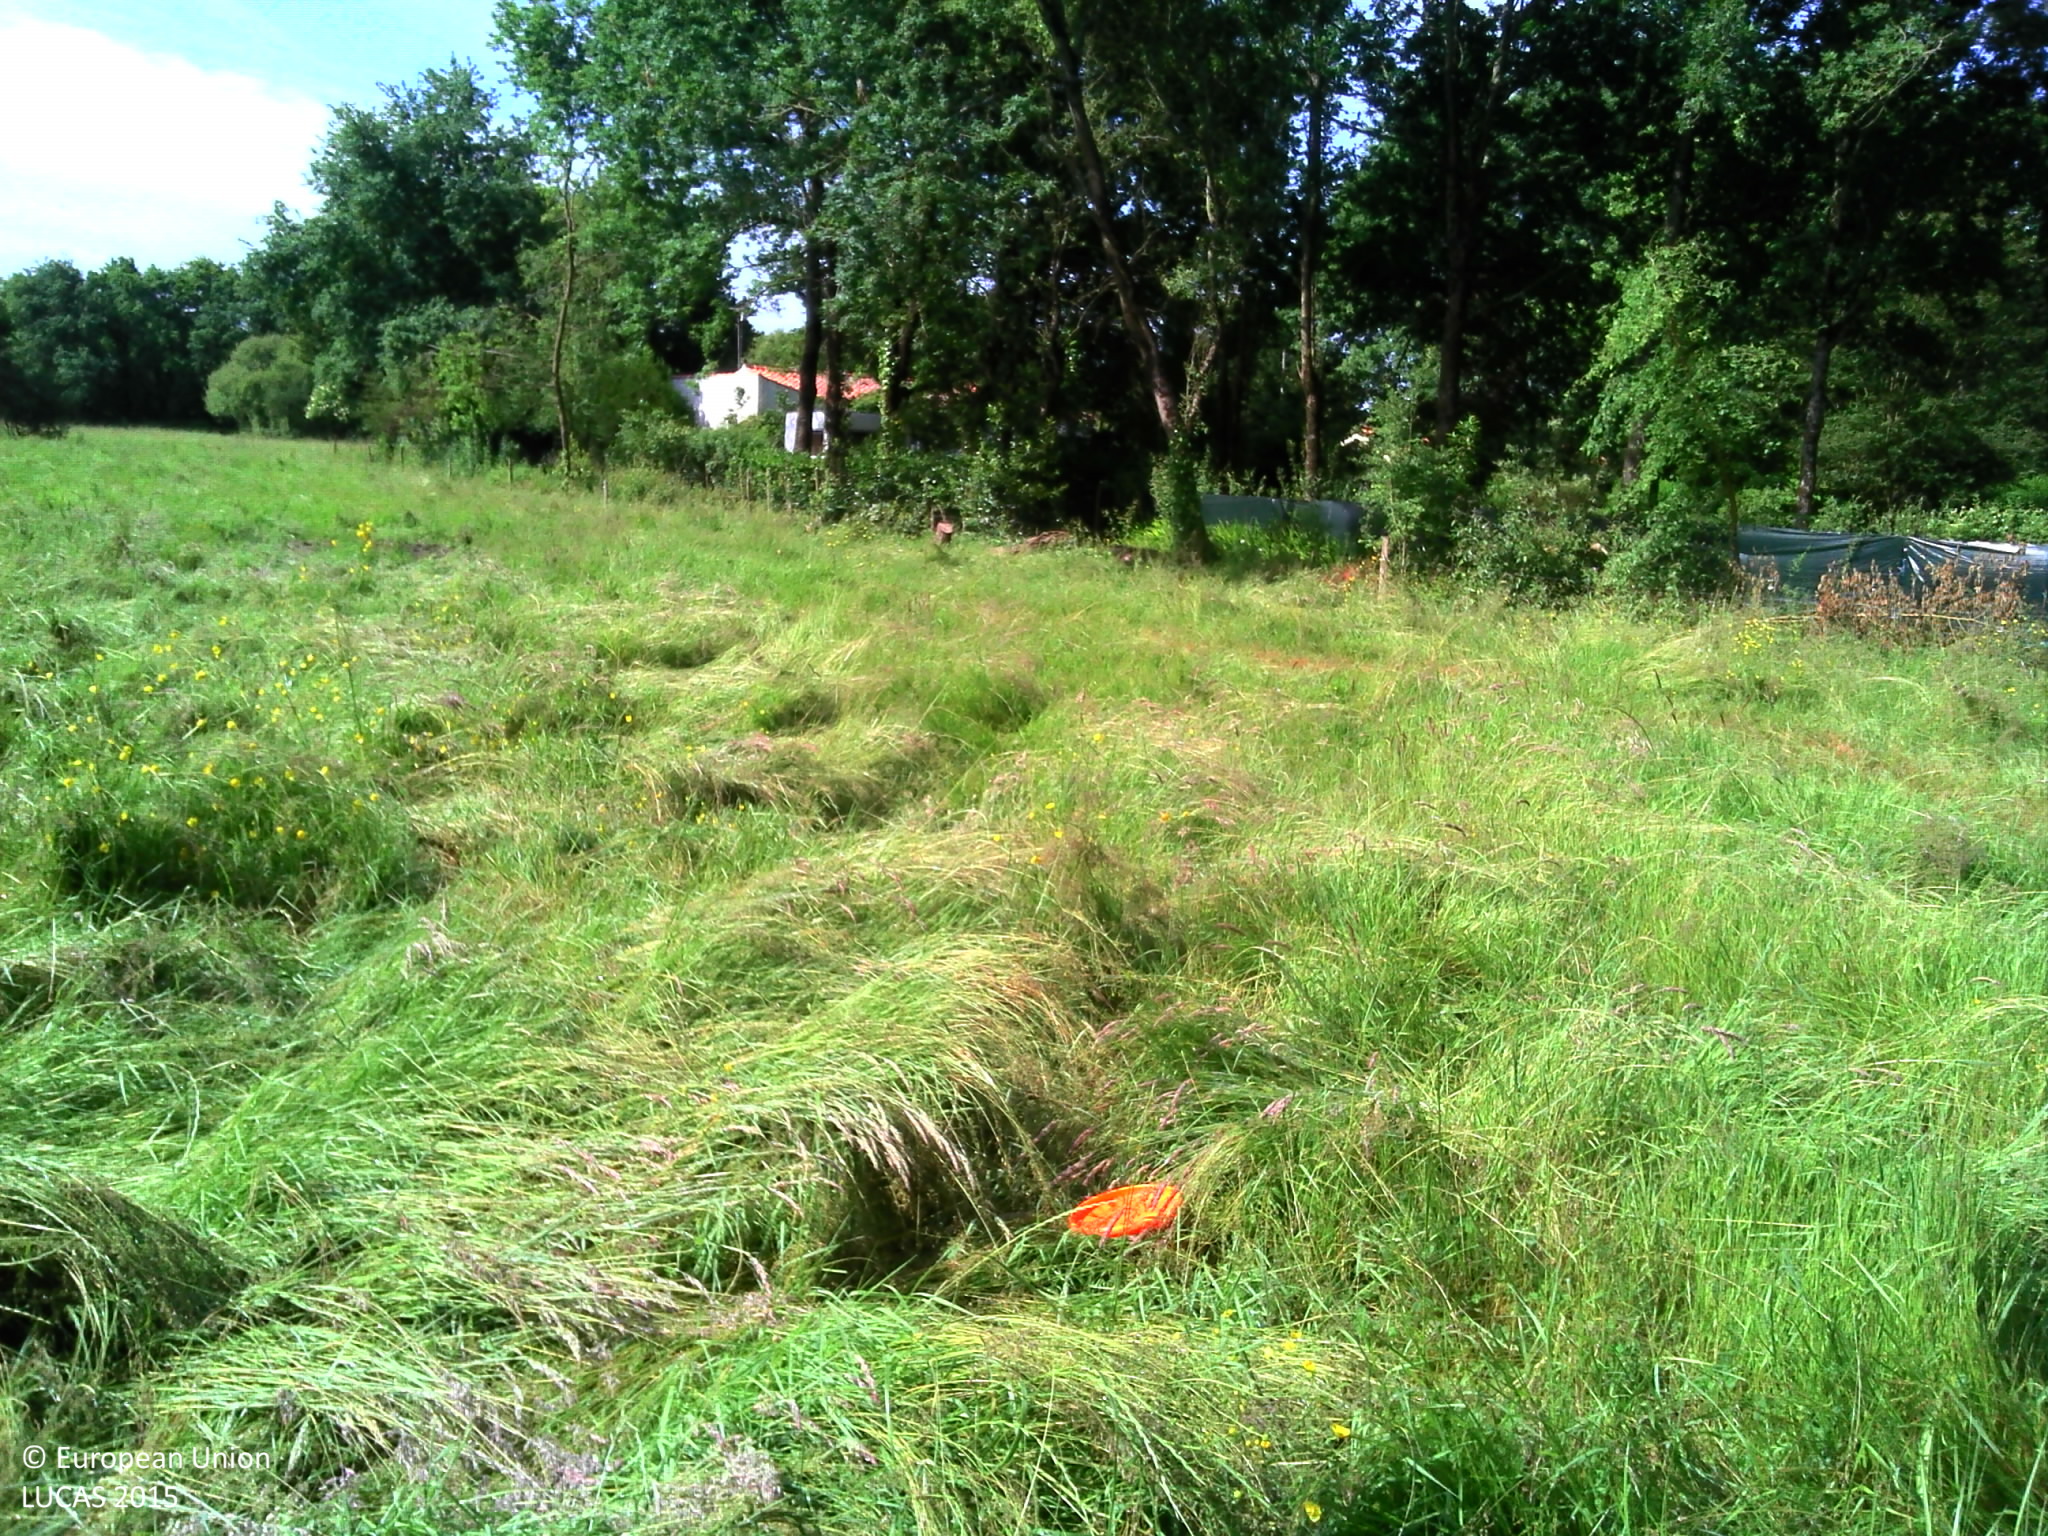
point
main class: Grassland
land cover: Grassland without tree/shrub cover
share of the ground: > 75 %
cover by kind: herbaceous plants 100 %
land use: Agriculture (excluding fallow land and kitchen gardens)
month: June
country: FR
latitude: 46.9302
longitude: -1.9853
